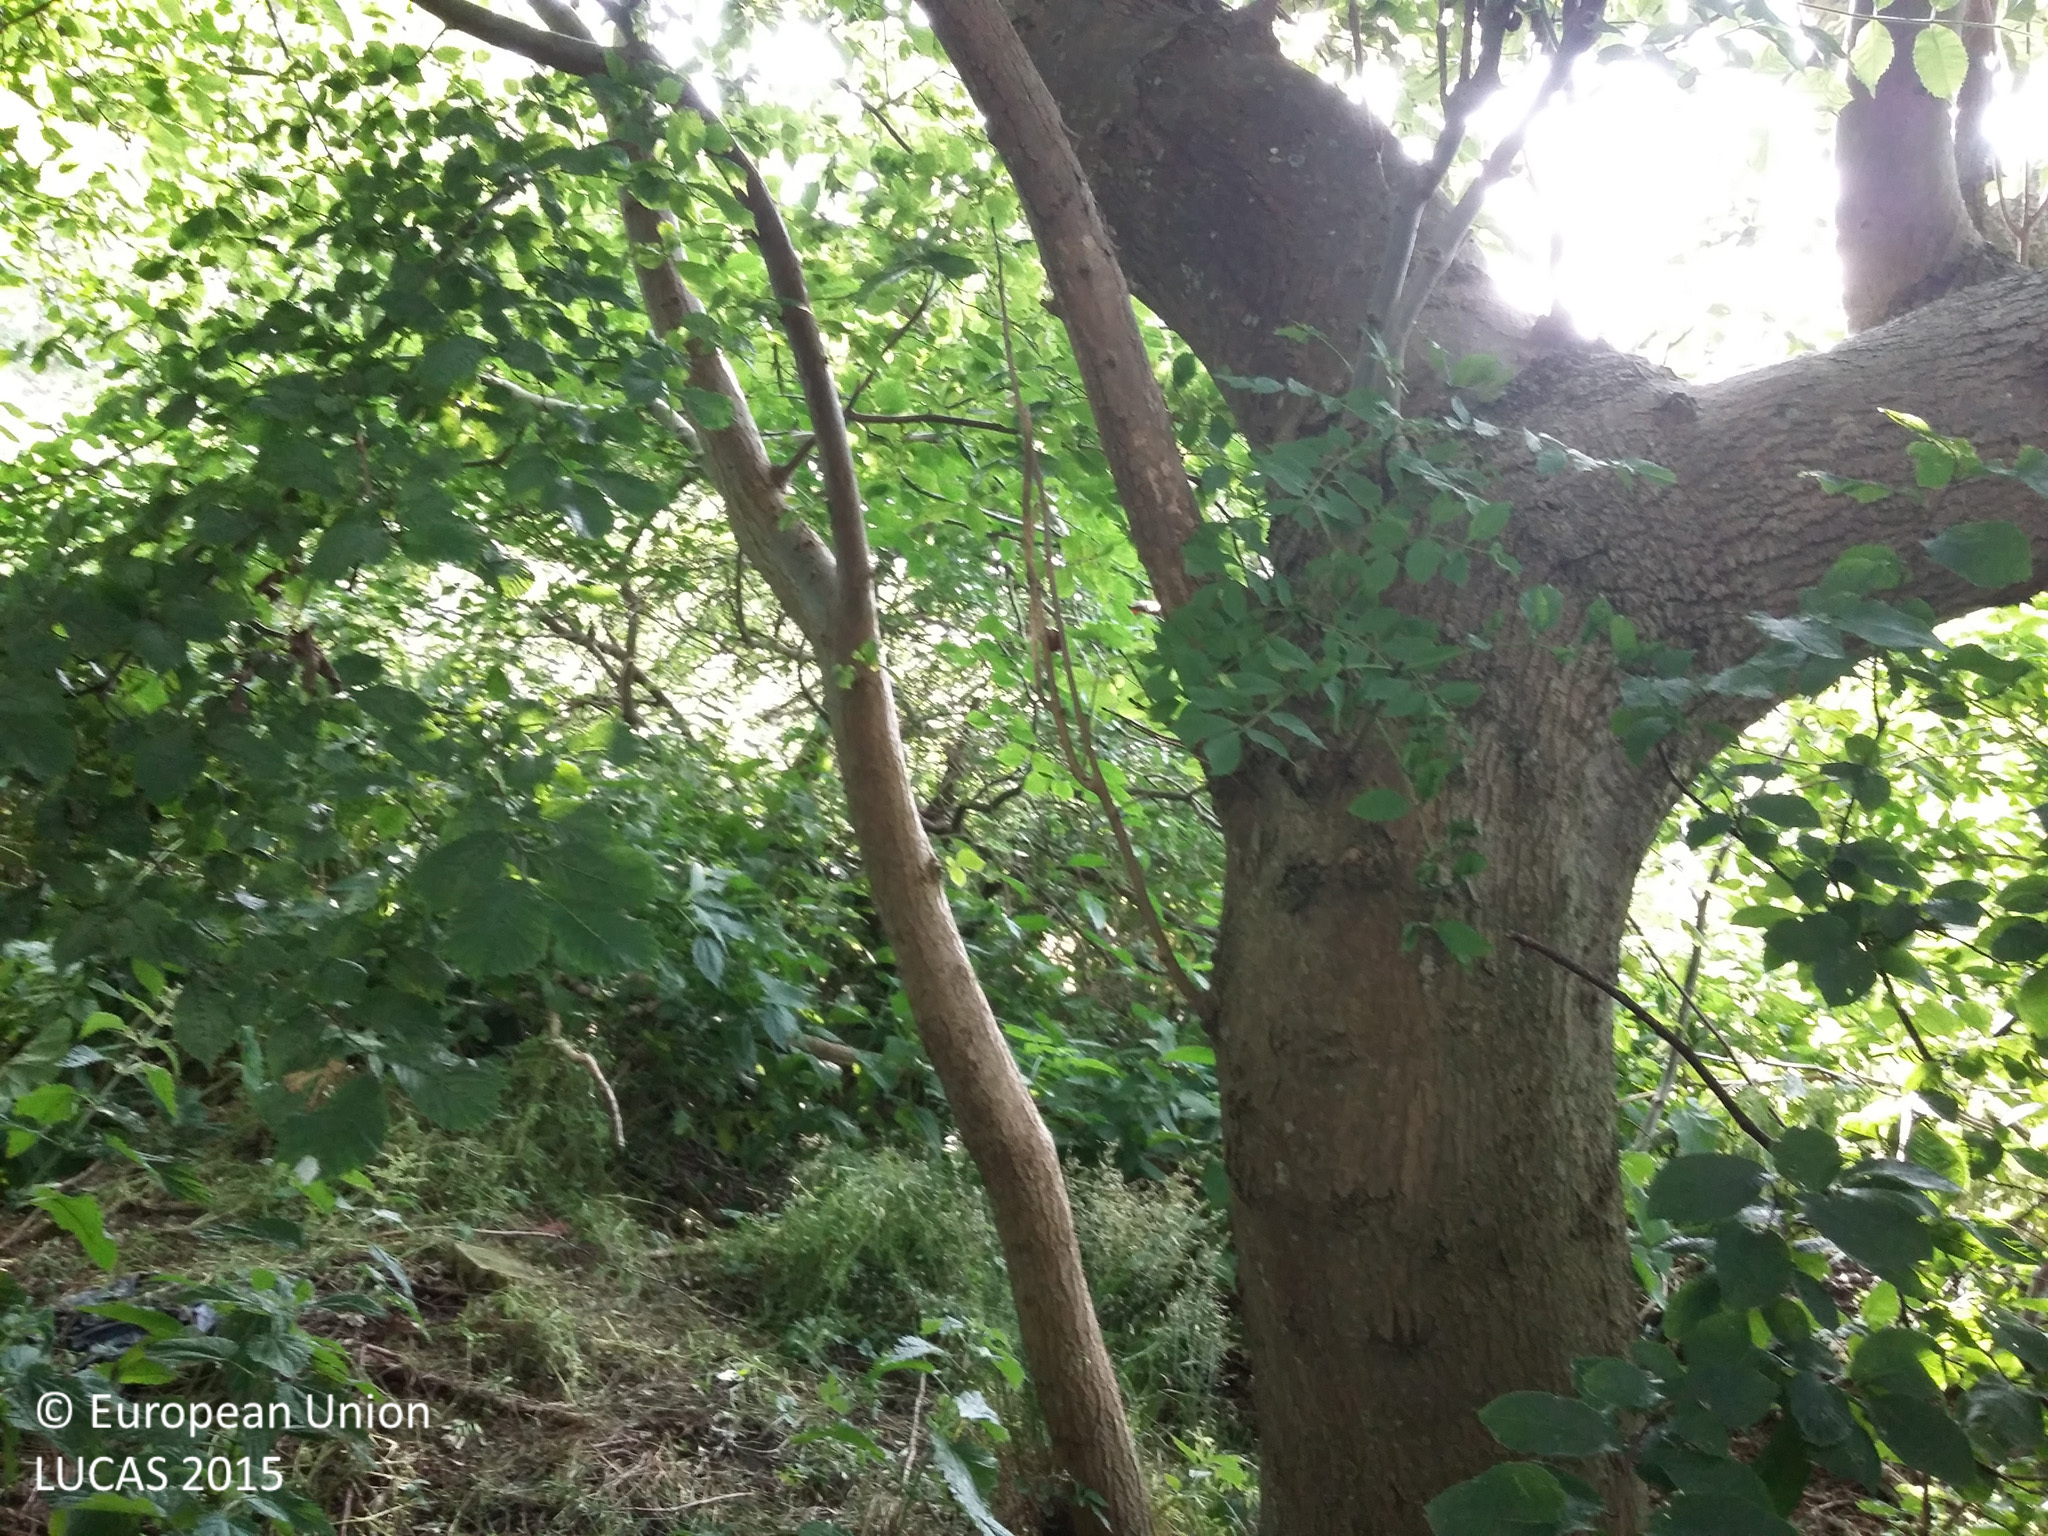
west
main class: Woodland
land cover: Broadleaved woodland
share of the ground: > 75 %
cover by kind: broadleaved forest trees 70 %, herbaceous plants 30 %
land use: Semi-natural and natural areas not in use
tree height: > 5 m
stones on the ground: < 10 %
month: July
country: DK
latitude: 55.8132
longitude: 11.9610
